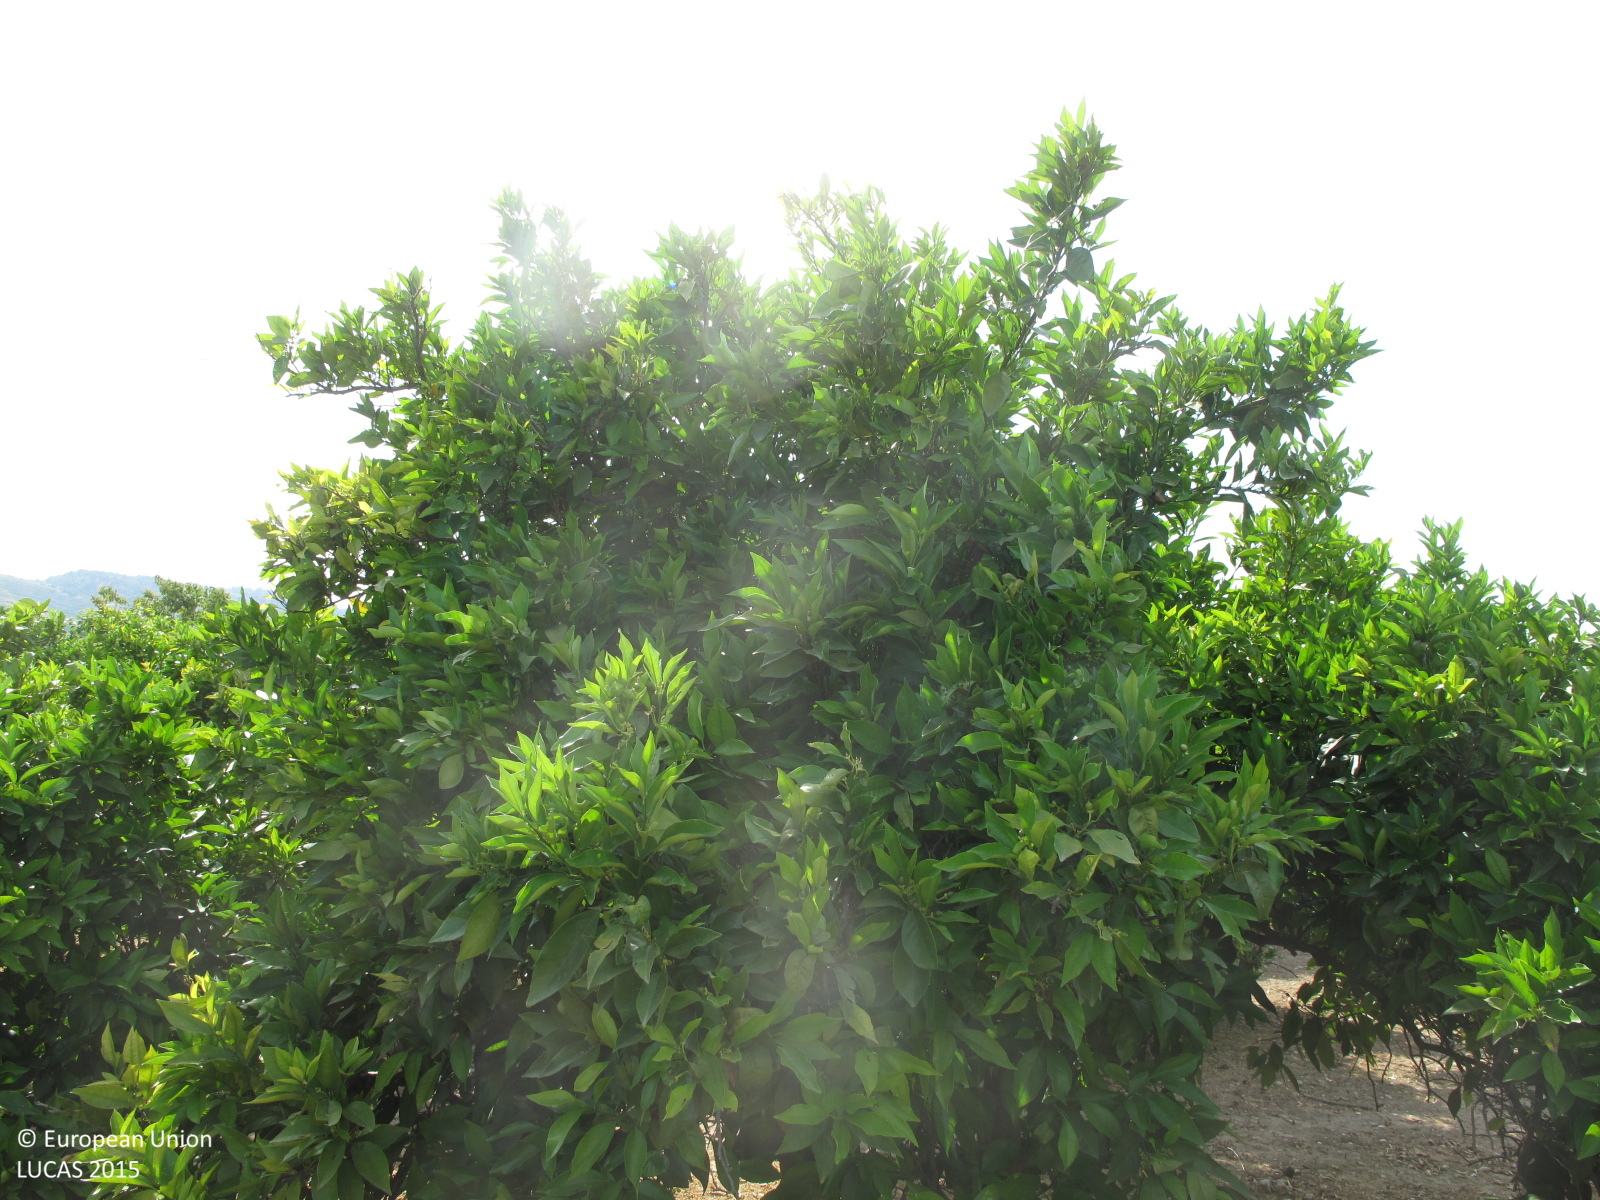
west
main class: Cropland
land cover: Oranges
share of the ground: > 75 %
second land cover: Other bare soil
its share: > 75 %
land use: Agriculture (excluding fallow land and kitchen gardens)
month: May
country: ES
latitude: 39.0720
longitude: -0.5930
